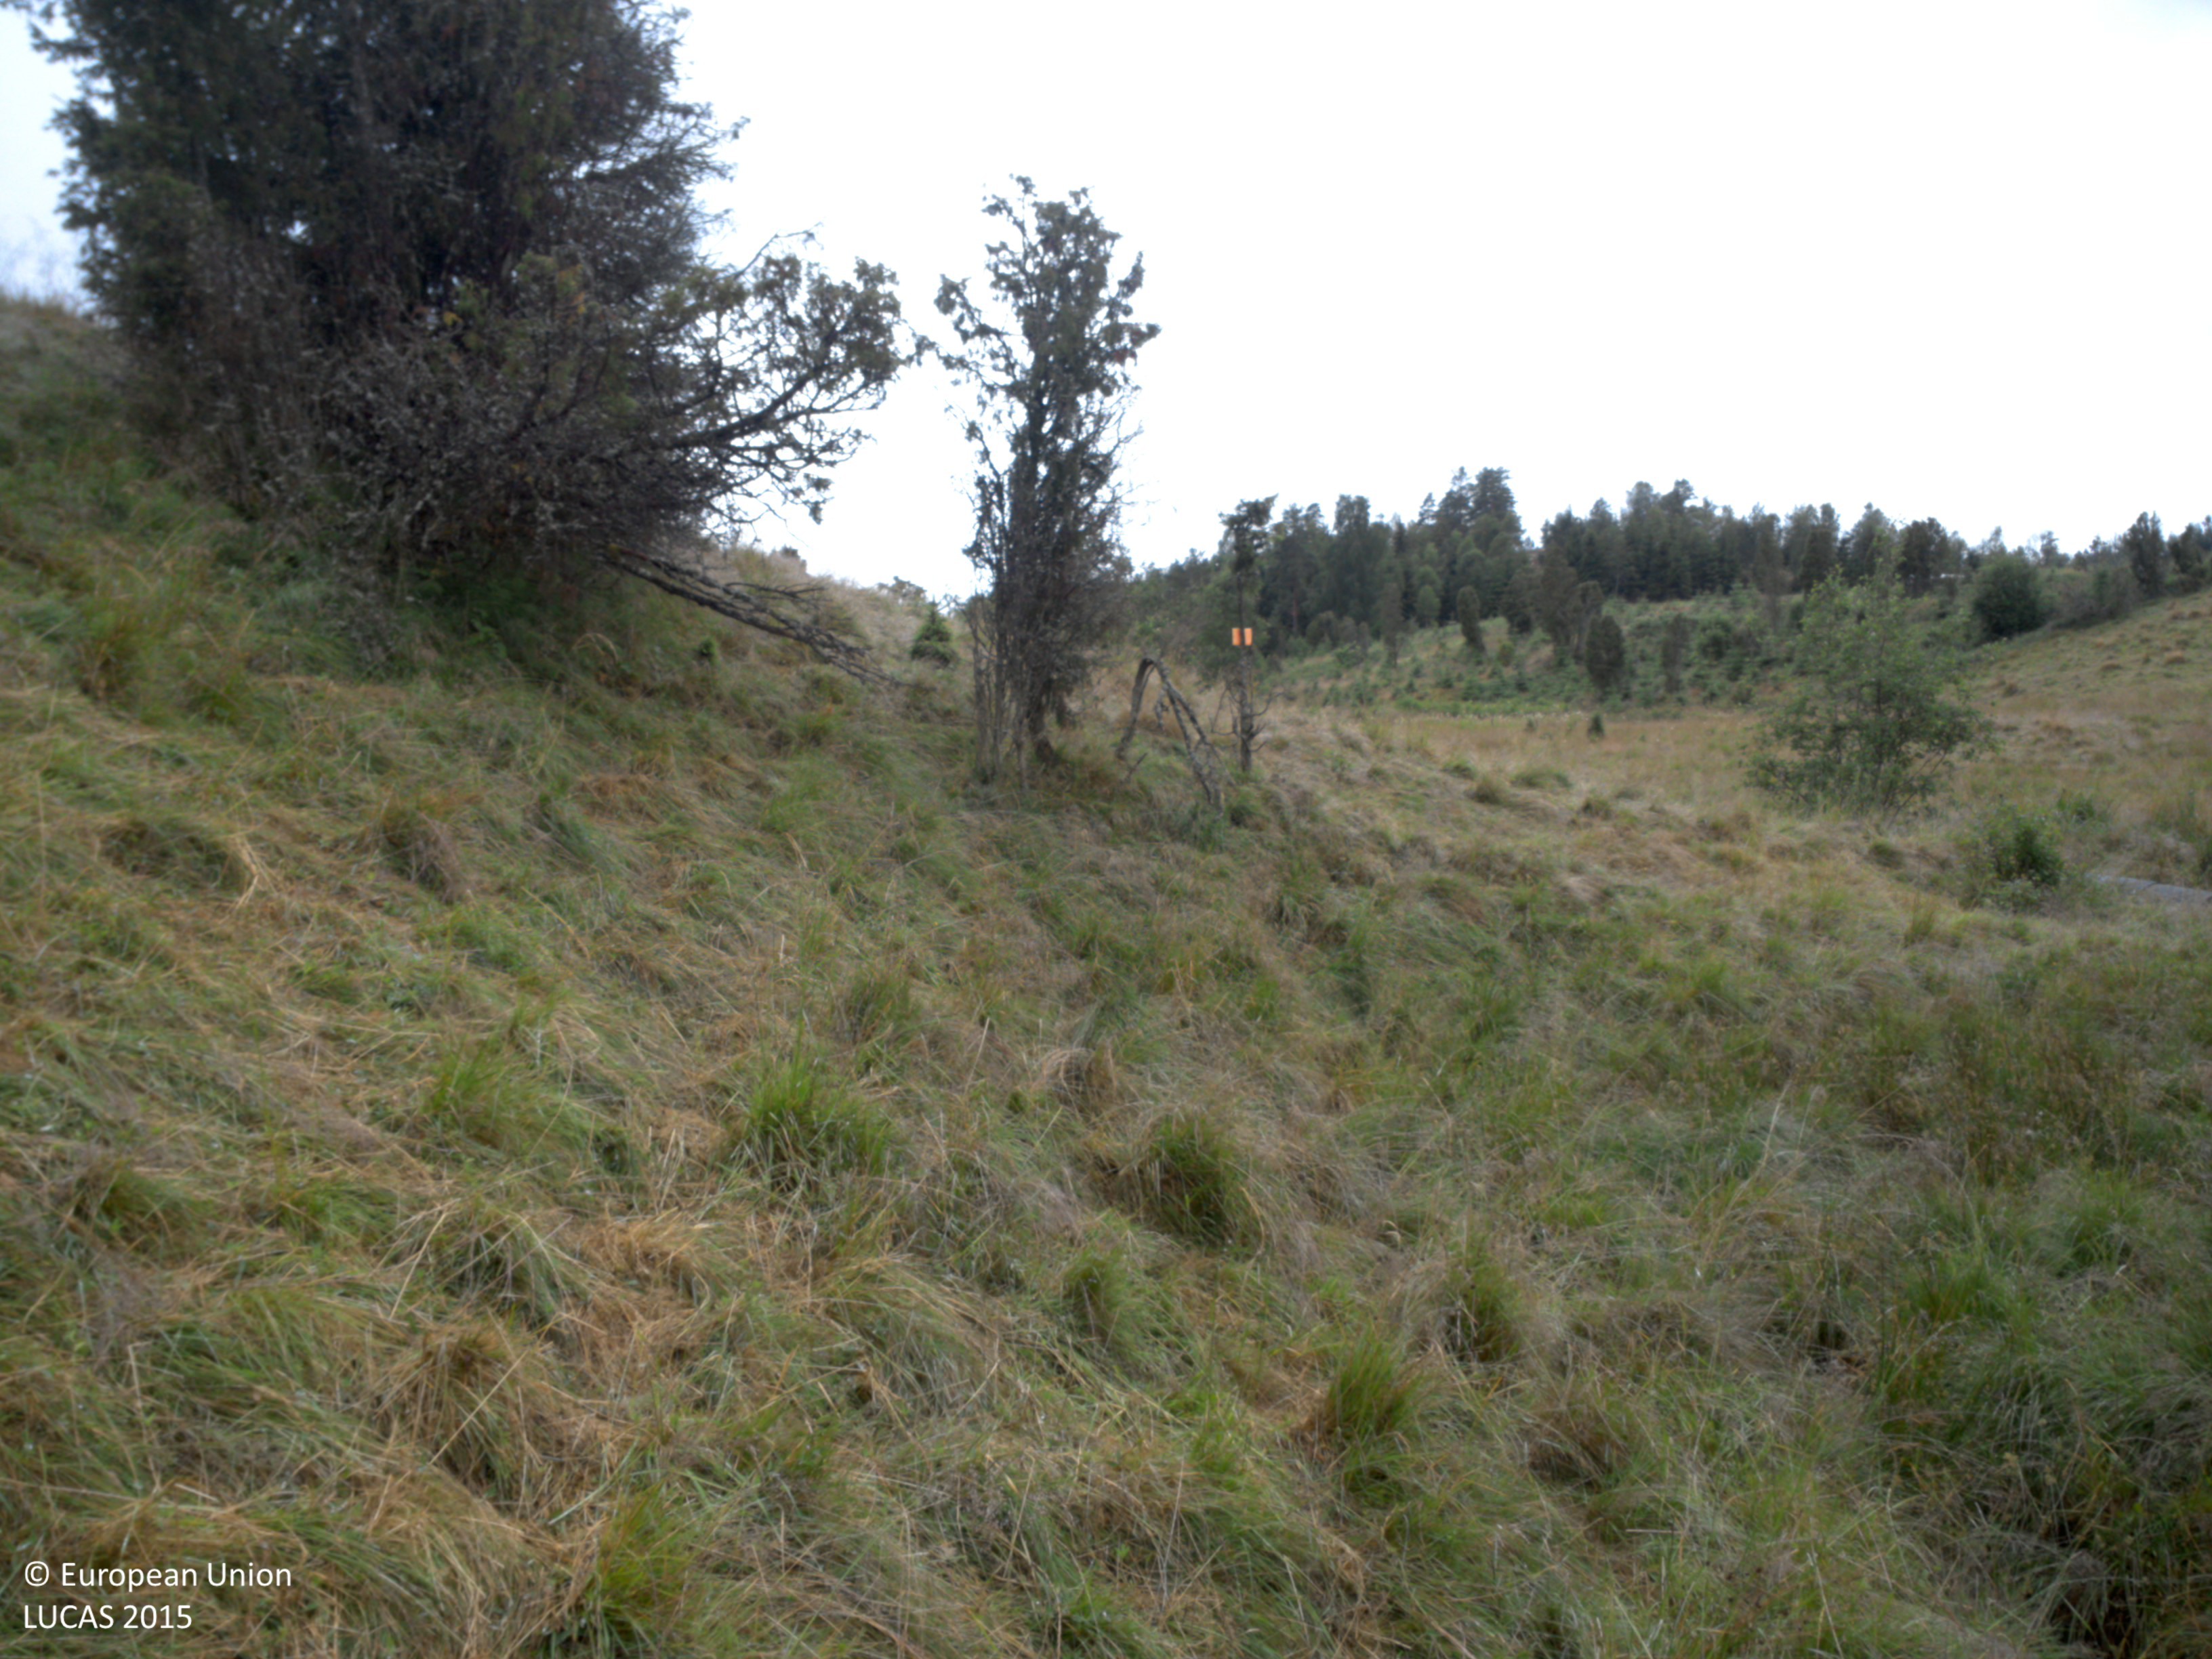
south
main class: Grassland
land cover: Grassland with sparse tree/shrub cover
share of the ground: > 75 %
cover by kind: herbaceous plants 95 %, coniferous forest trees 5 %
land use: Agriculture (excluding fallow land and kitchen gardens)
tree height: < 5 m
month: July
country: SE
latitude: 58.7291
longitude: 11.8095
